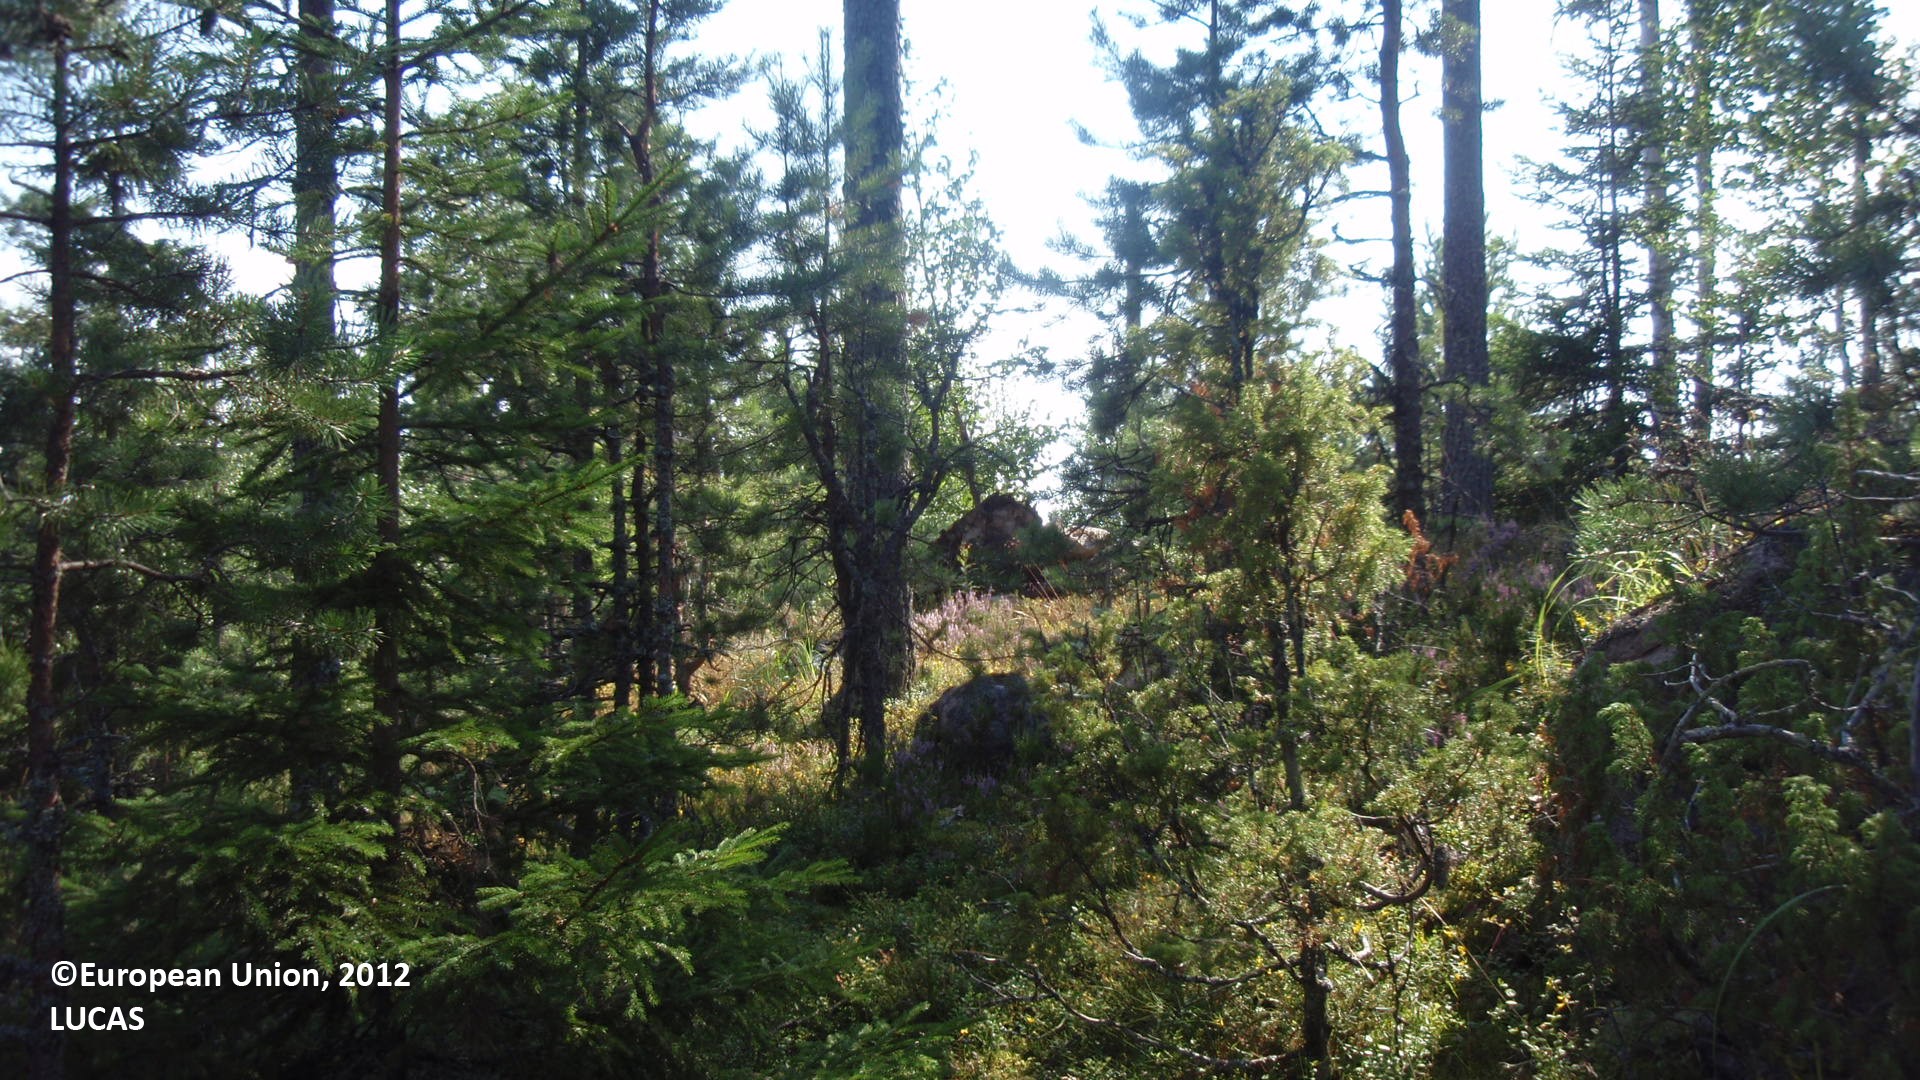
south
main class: Woodland
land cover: Pine dominated mixed woodland
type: boreal forest
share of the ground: 25 - 50 %
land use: Forestry
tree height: > 5 m
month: July
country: FI
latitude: 61.3796
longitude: 28.4582
